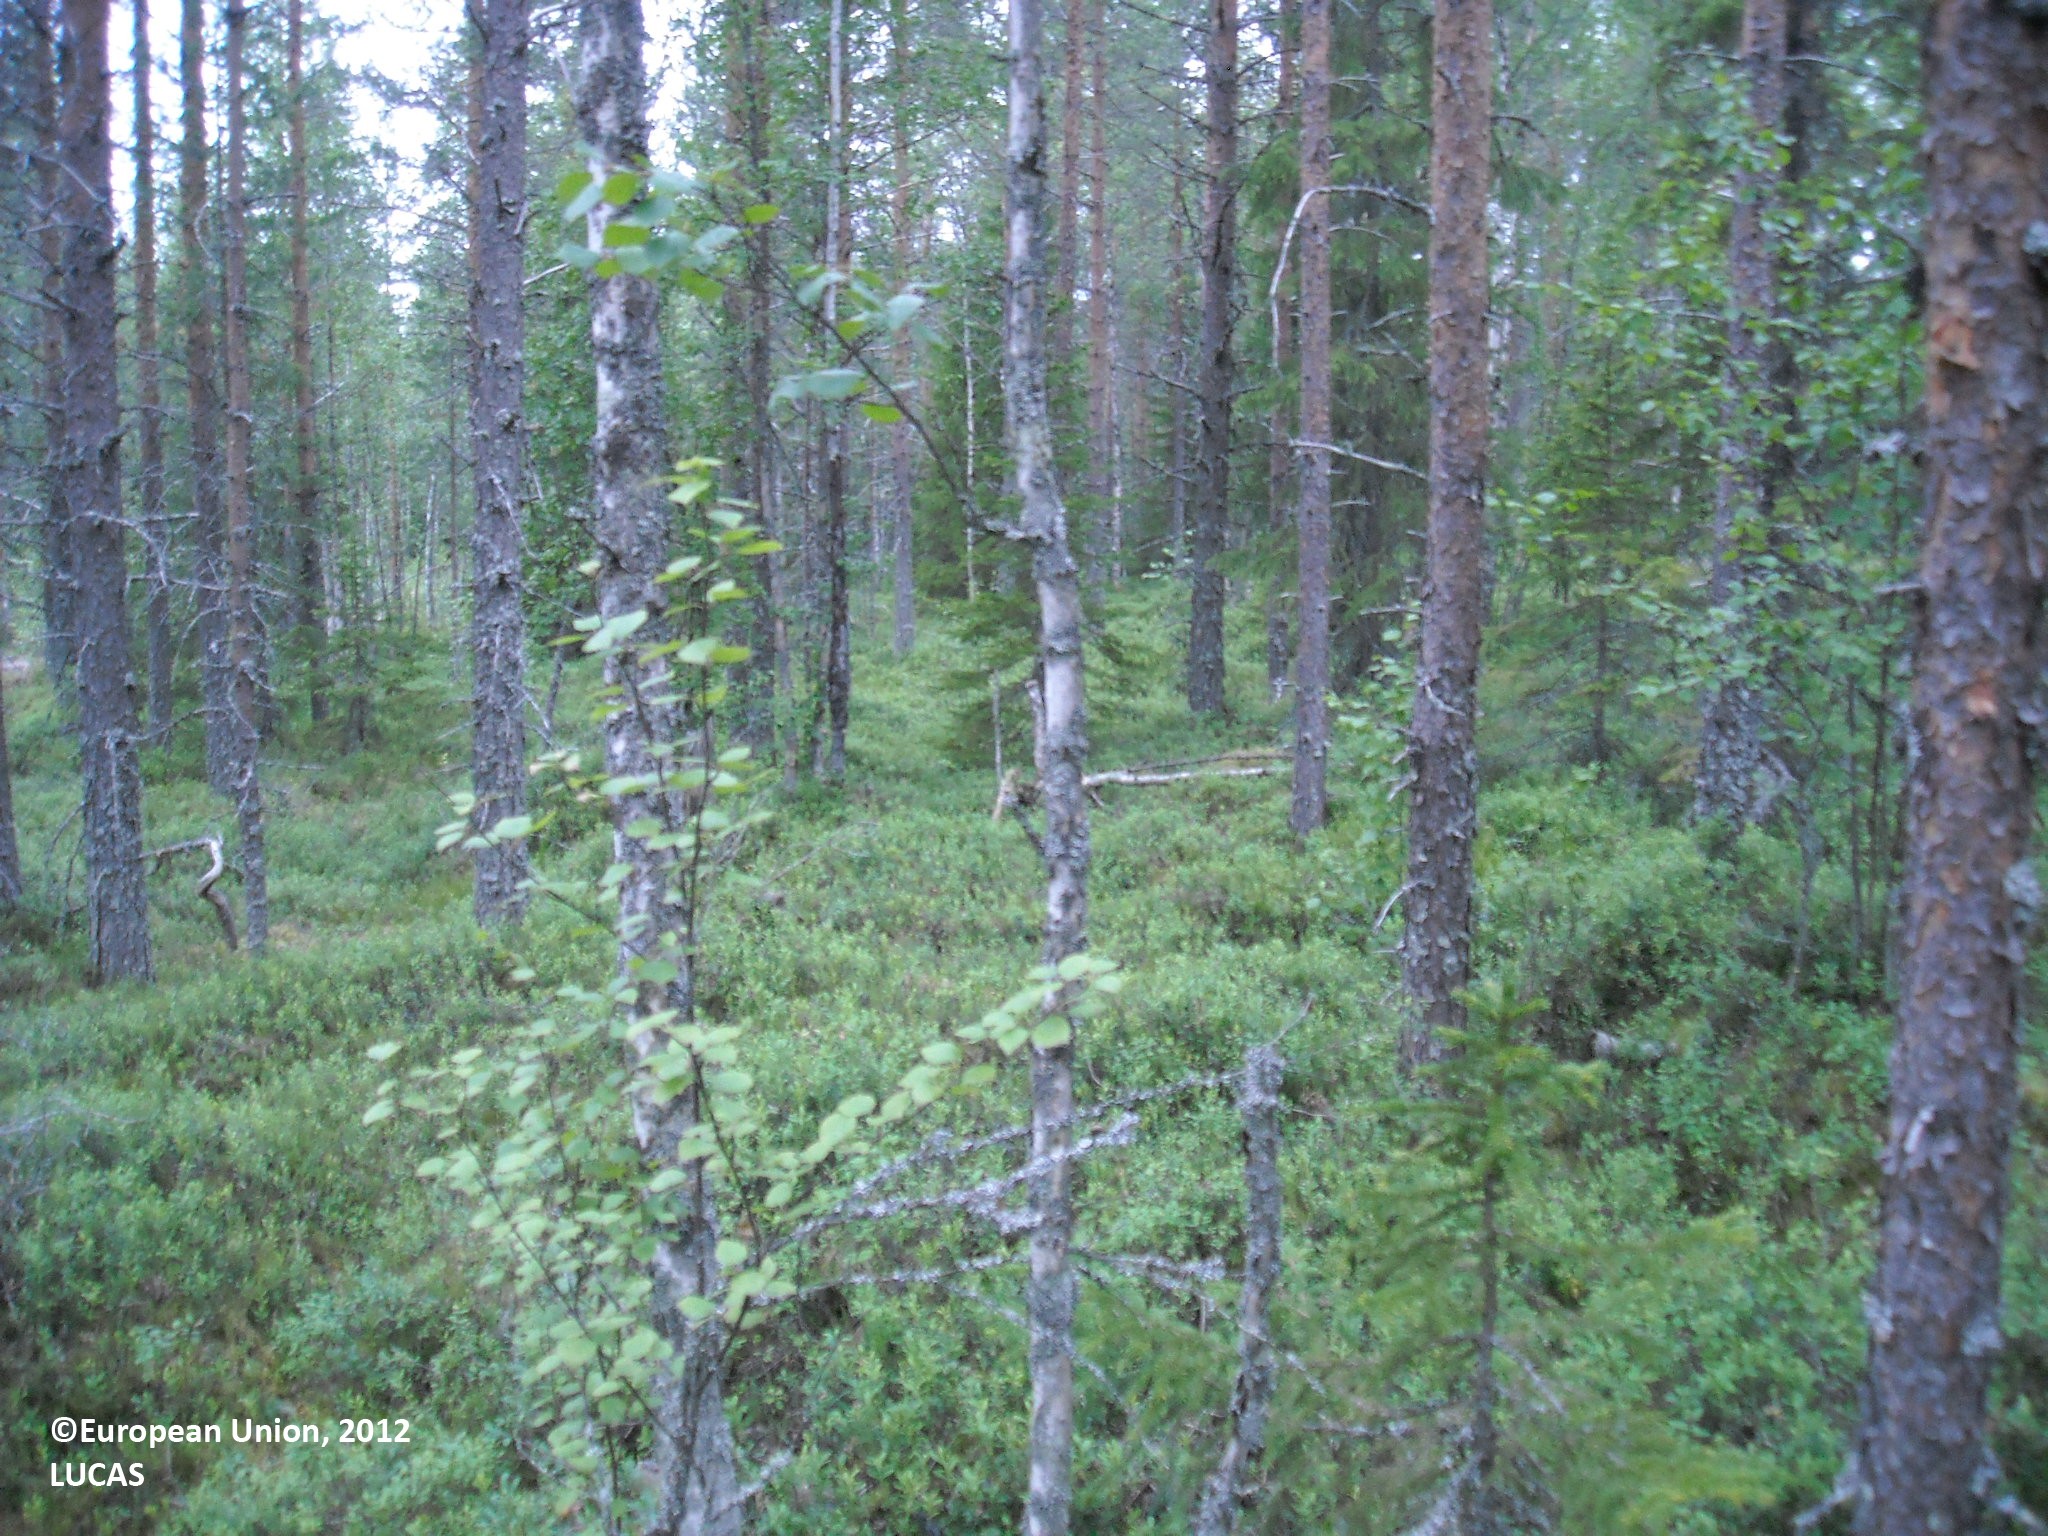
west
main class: Woodland
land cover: Pine dominated coniferous woodland
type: boreal forest
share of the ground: 50 - 75 %
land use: Forestry
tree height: > 5 m
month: July
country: FI
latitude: 64.8221
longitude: 26.8684
